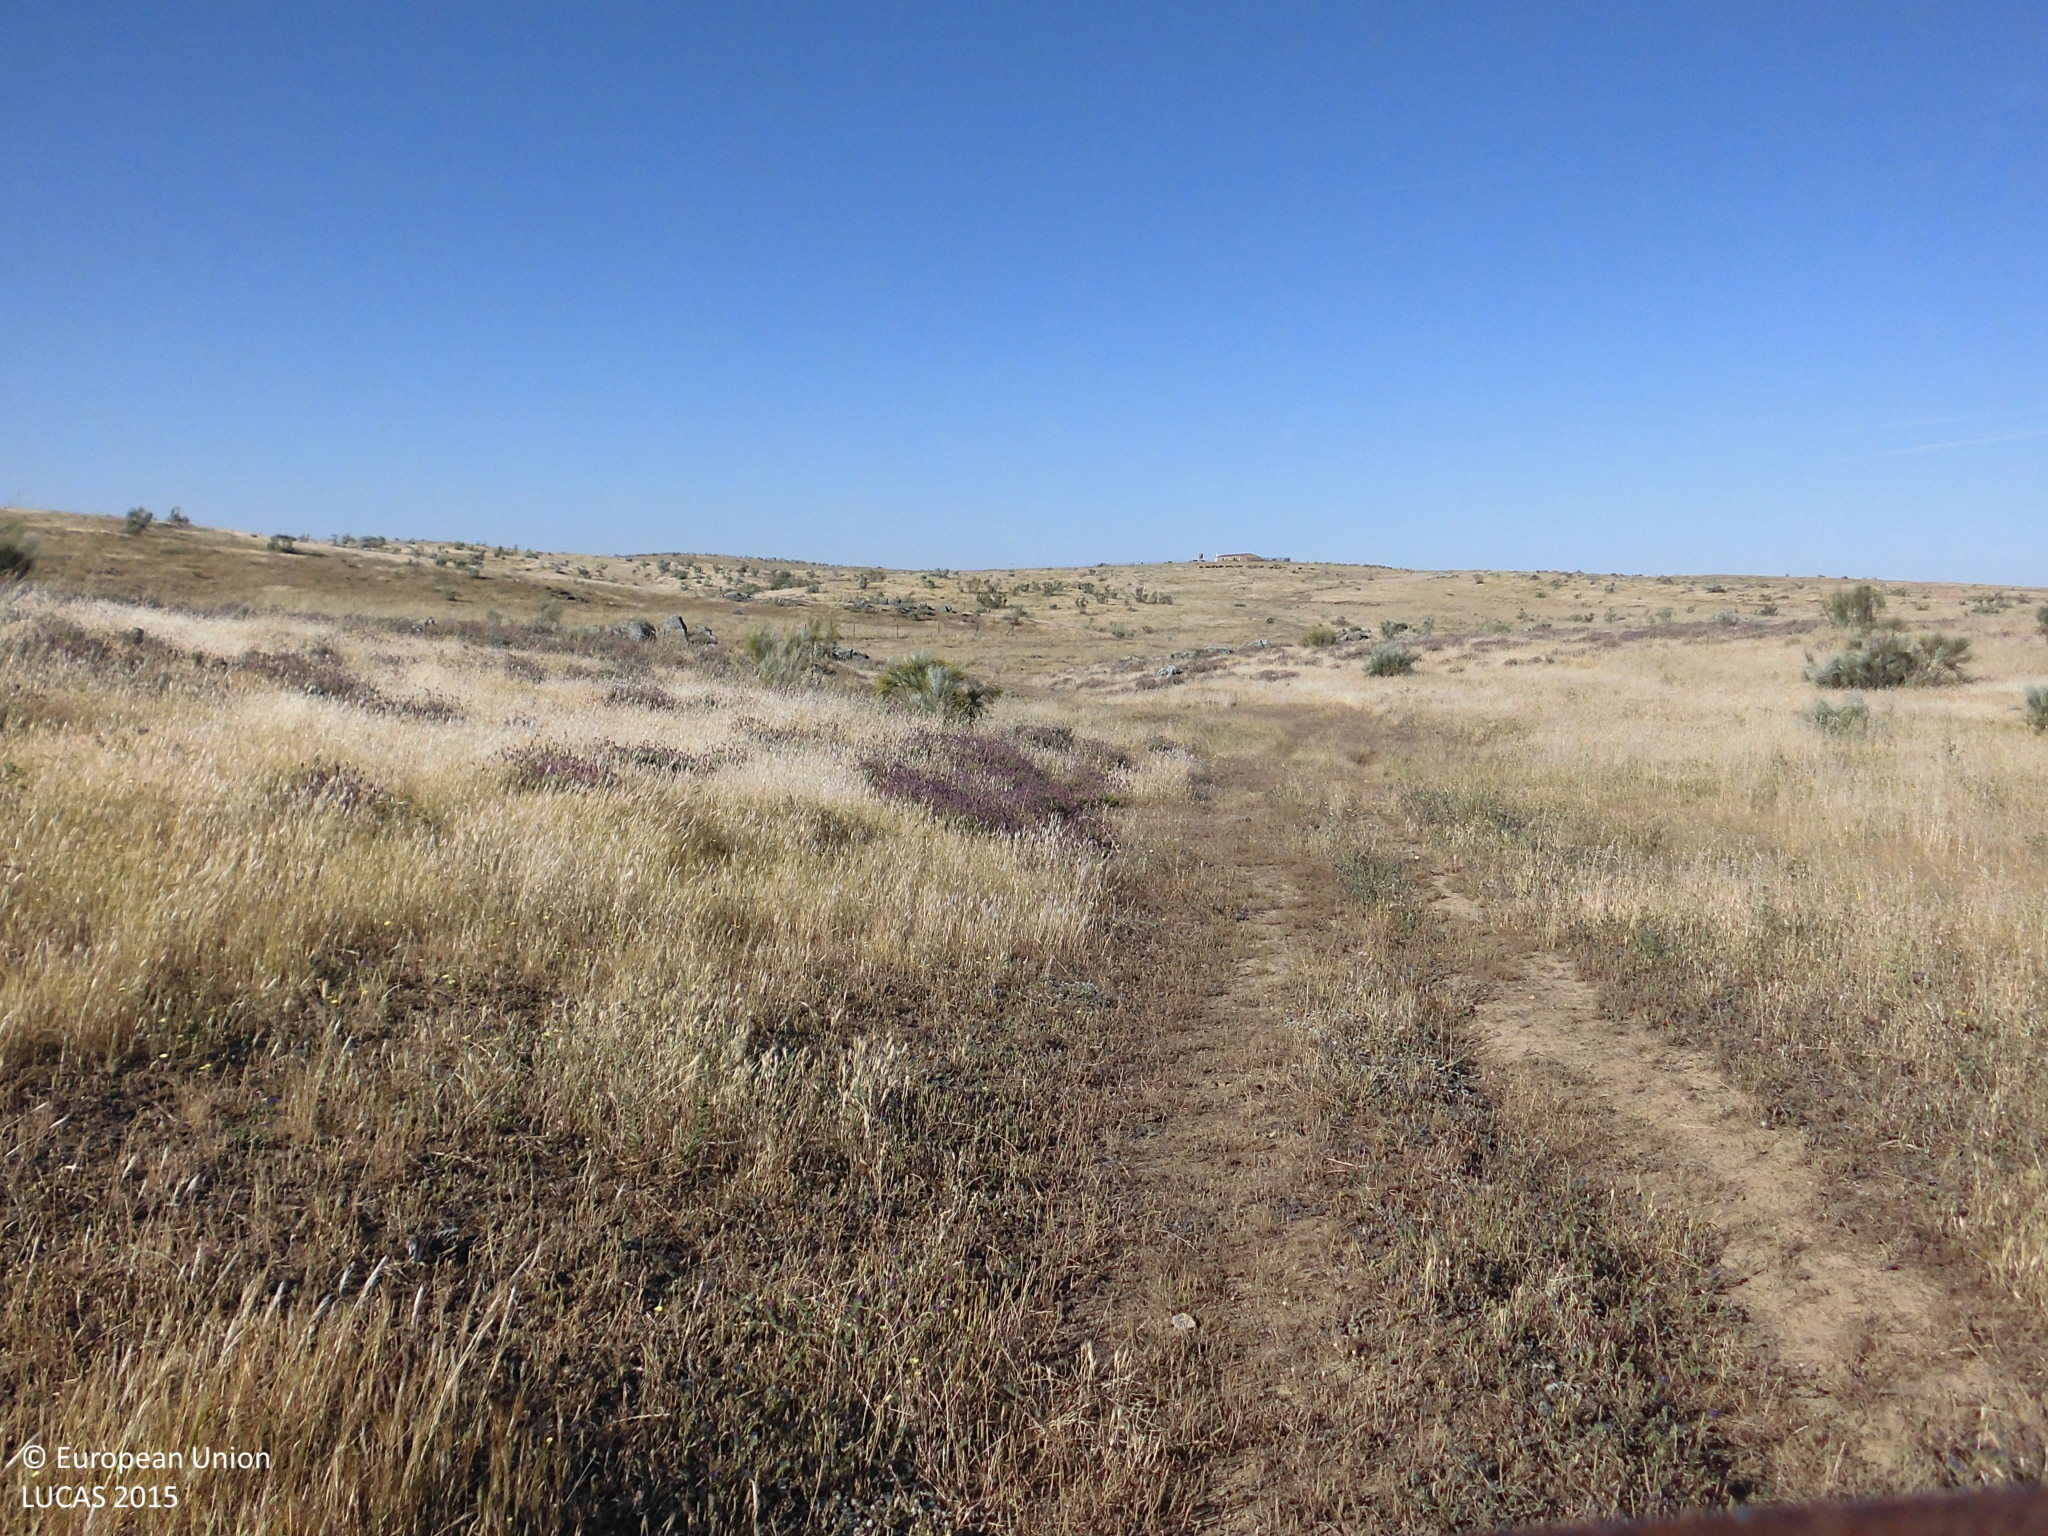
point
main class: Woodland
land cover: Broadleaved woodland
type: broadleaved evergreen forest
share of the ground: 10 - 25 %
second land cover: Grassland without tree/shrub cover
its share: > 75 %
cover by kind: herbaceous plants 85 %, broadleaved forest trees 15 %
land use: Forestry
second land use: Agriculture (excluding fallow land and kitchen gardens)
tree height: > 5 m
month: May
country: ES
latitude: 39.4659
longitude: -6.8265
